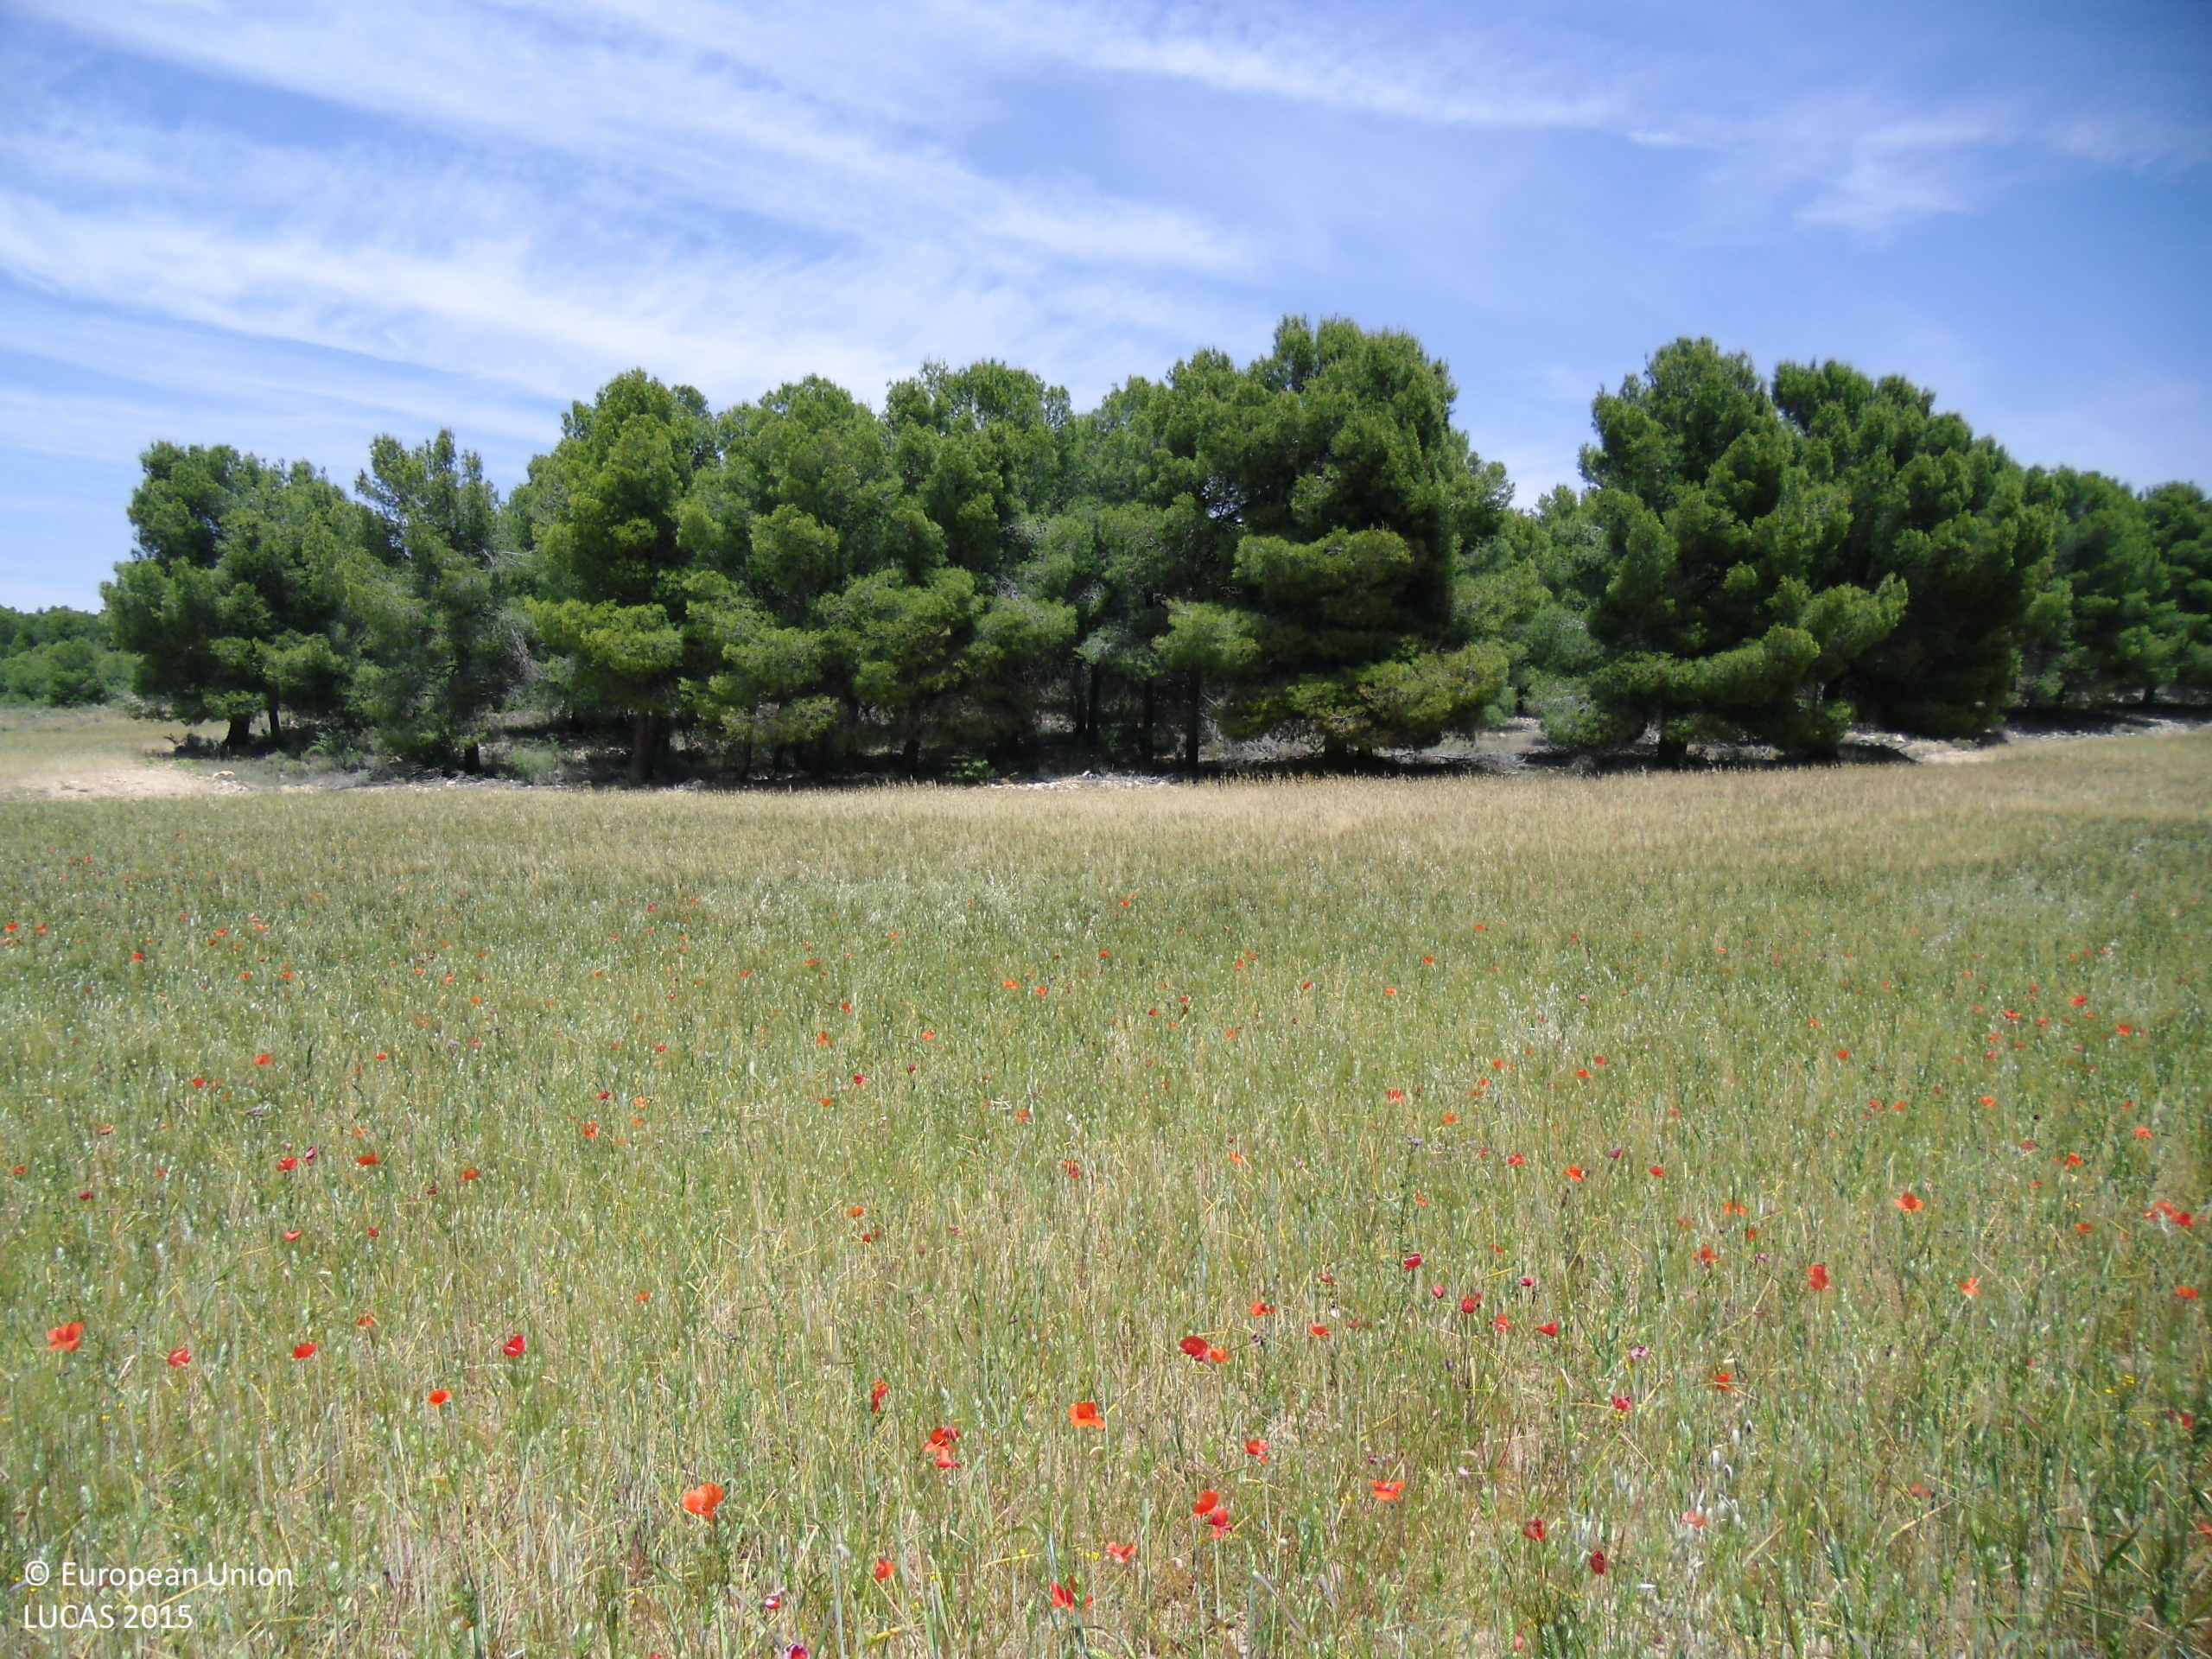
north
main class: Cropland
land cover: Mixed cereals for fodder
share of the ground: > 75 %
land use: Agriculture (excluding fallow land and kitchen gardens)
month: June
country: ES
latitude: 41.1000
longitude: -0.8873
